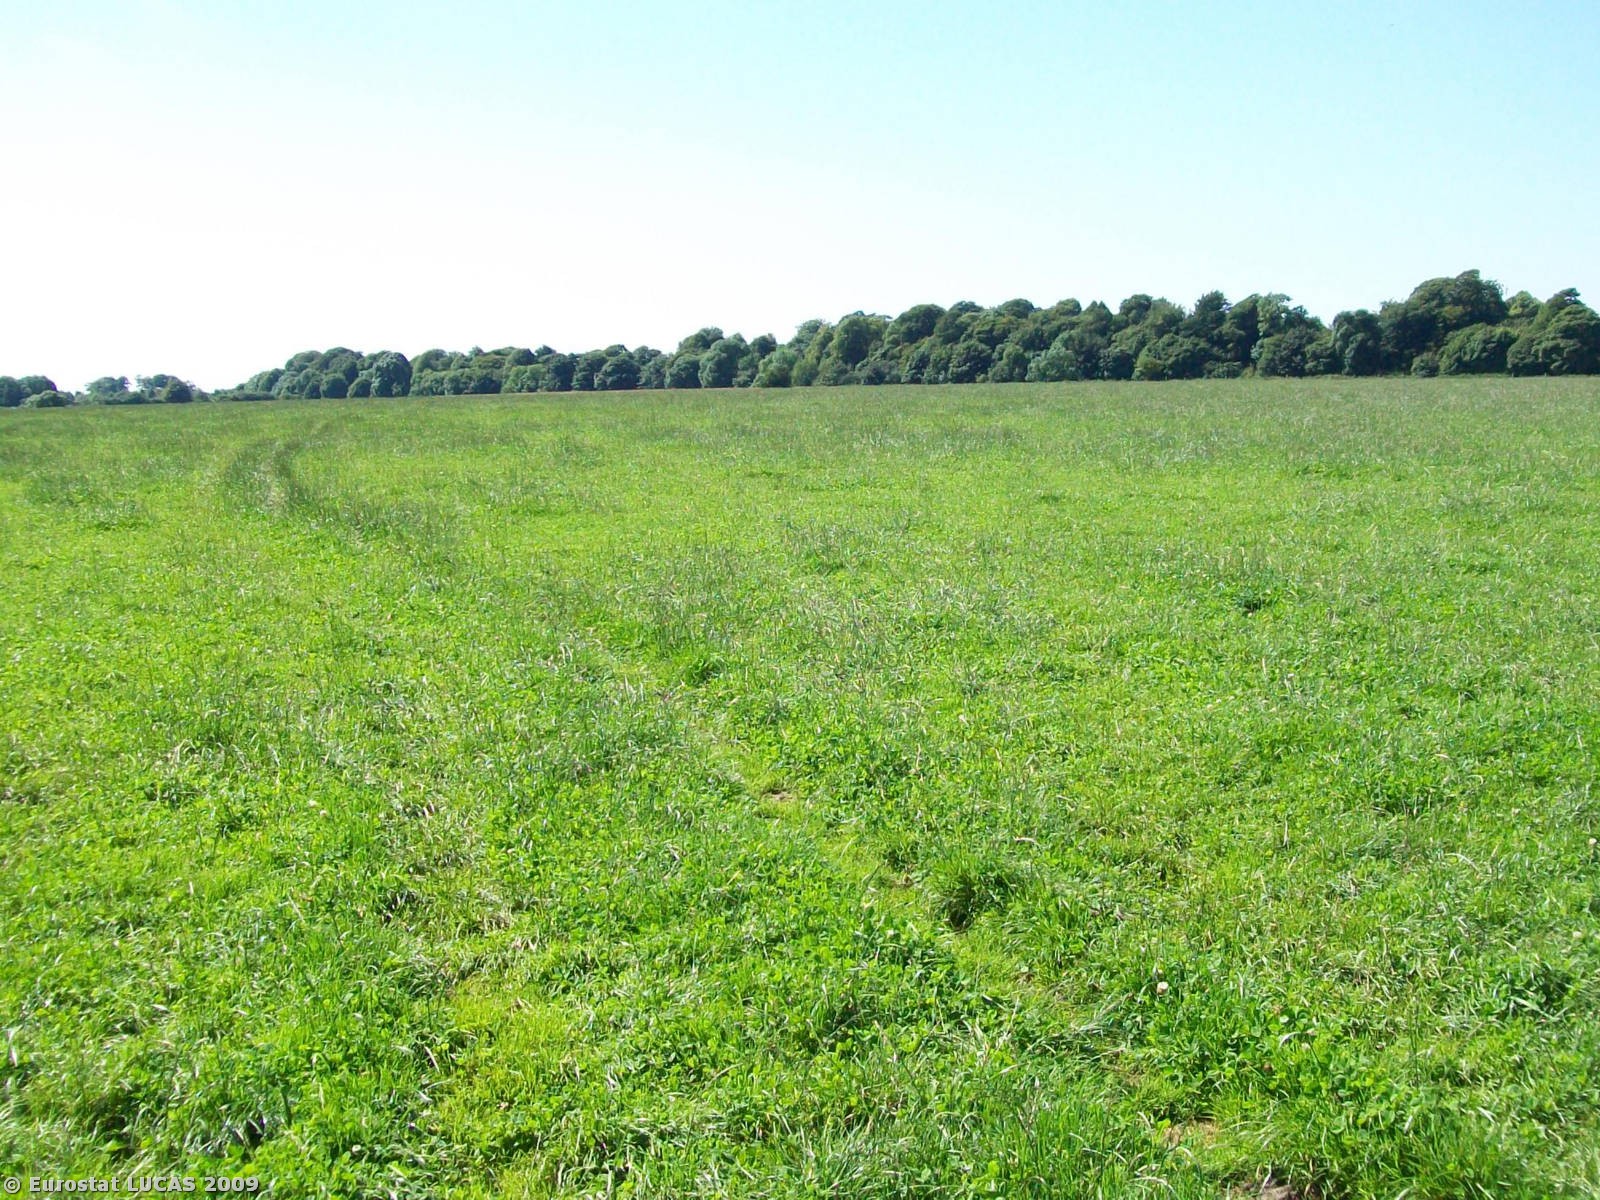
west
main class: Grassland
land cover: Grassland without tree/shrub cover
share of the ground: > 75 %
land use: Agriculture (excluding fallow land and kitchen gardens)
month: August
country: GB
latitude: 50.2031
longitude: -5.1810
